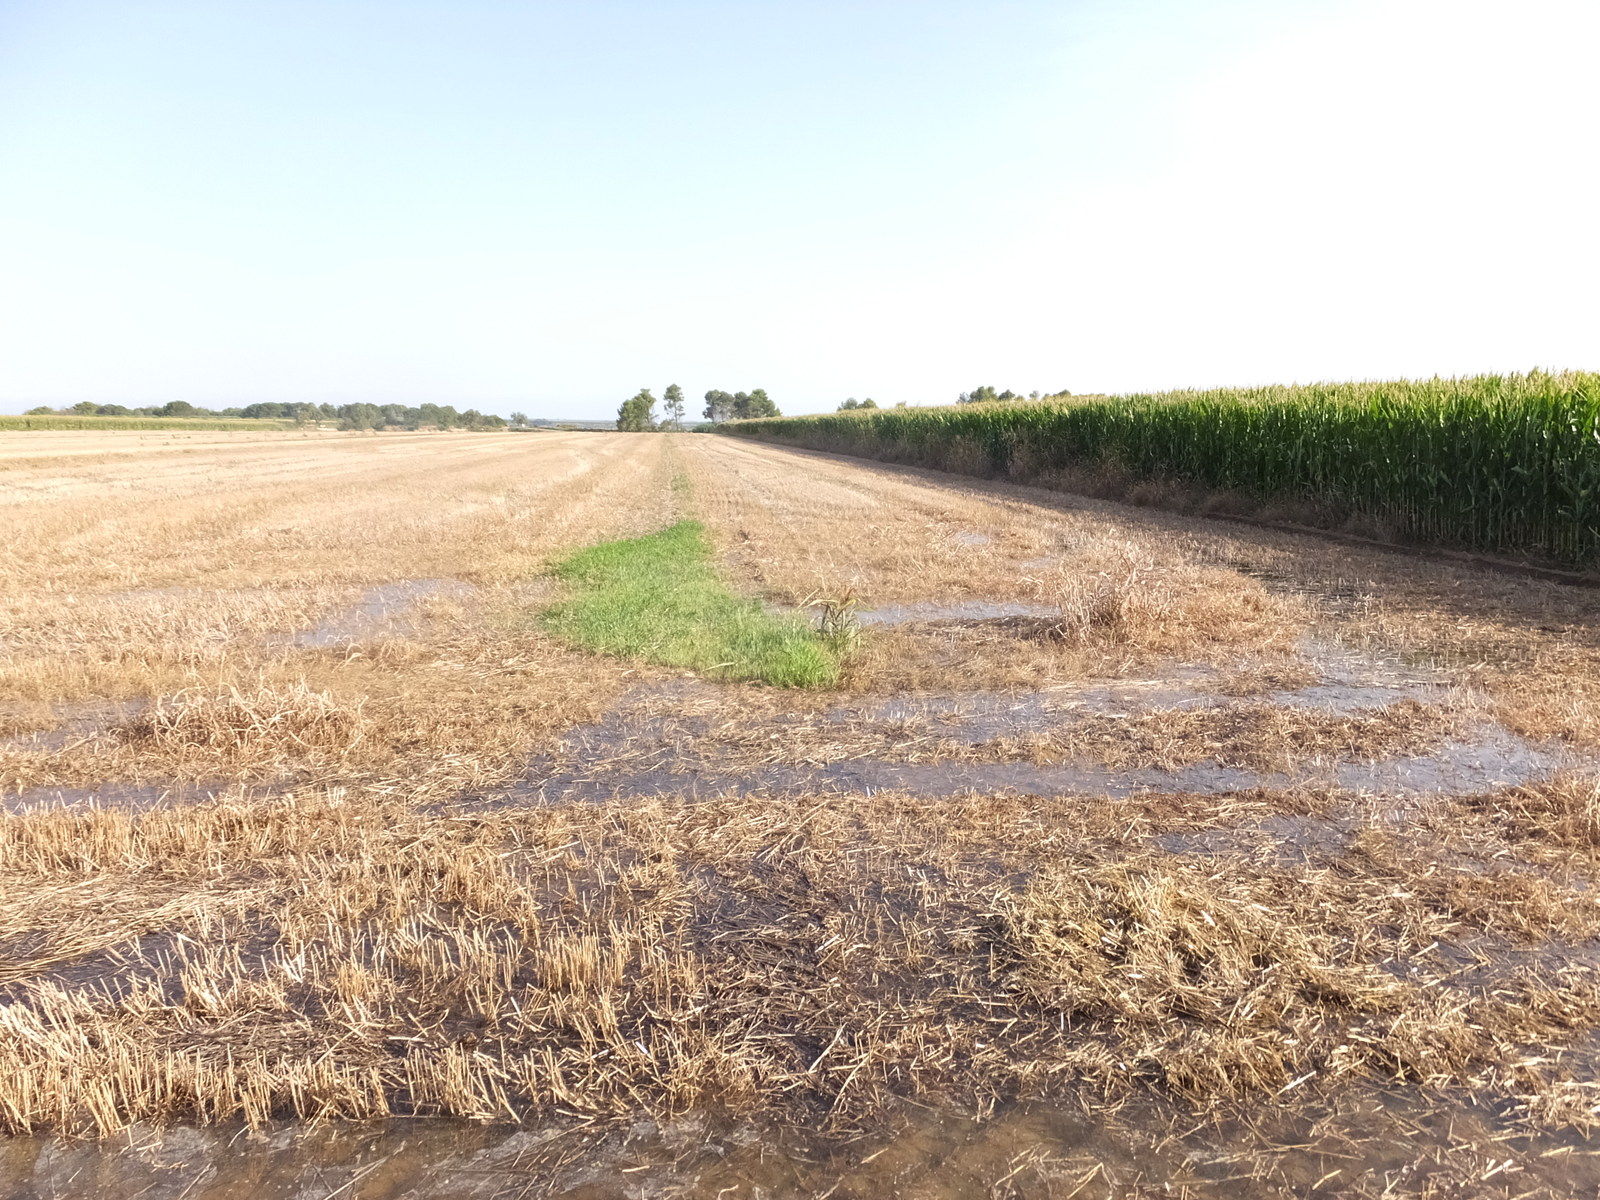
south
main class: Cropland
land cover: Common wheat
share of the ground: < 10 %
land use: Agriculture (excluding fallow land and kitchen gardens)
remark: Harvested field
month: August
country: ES
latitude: 41.6307
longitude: 0.3714
